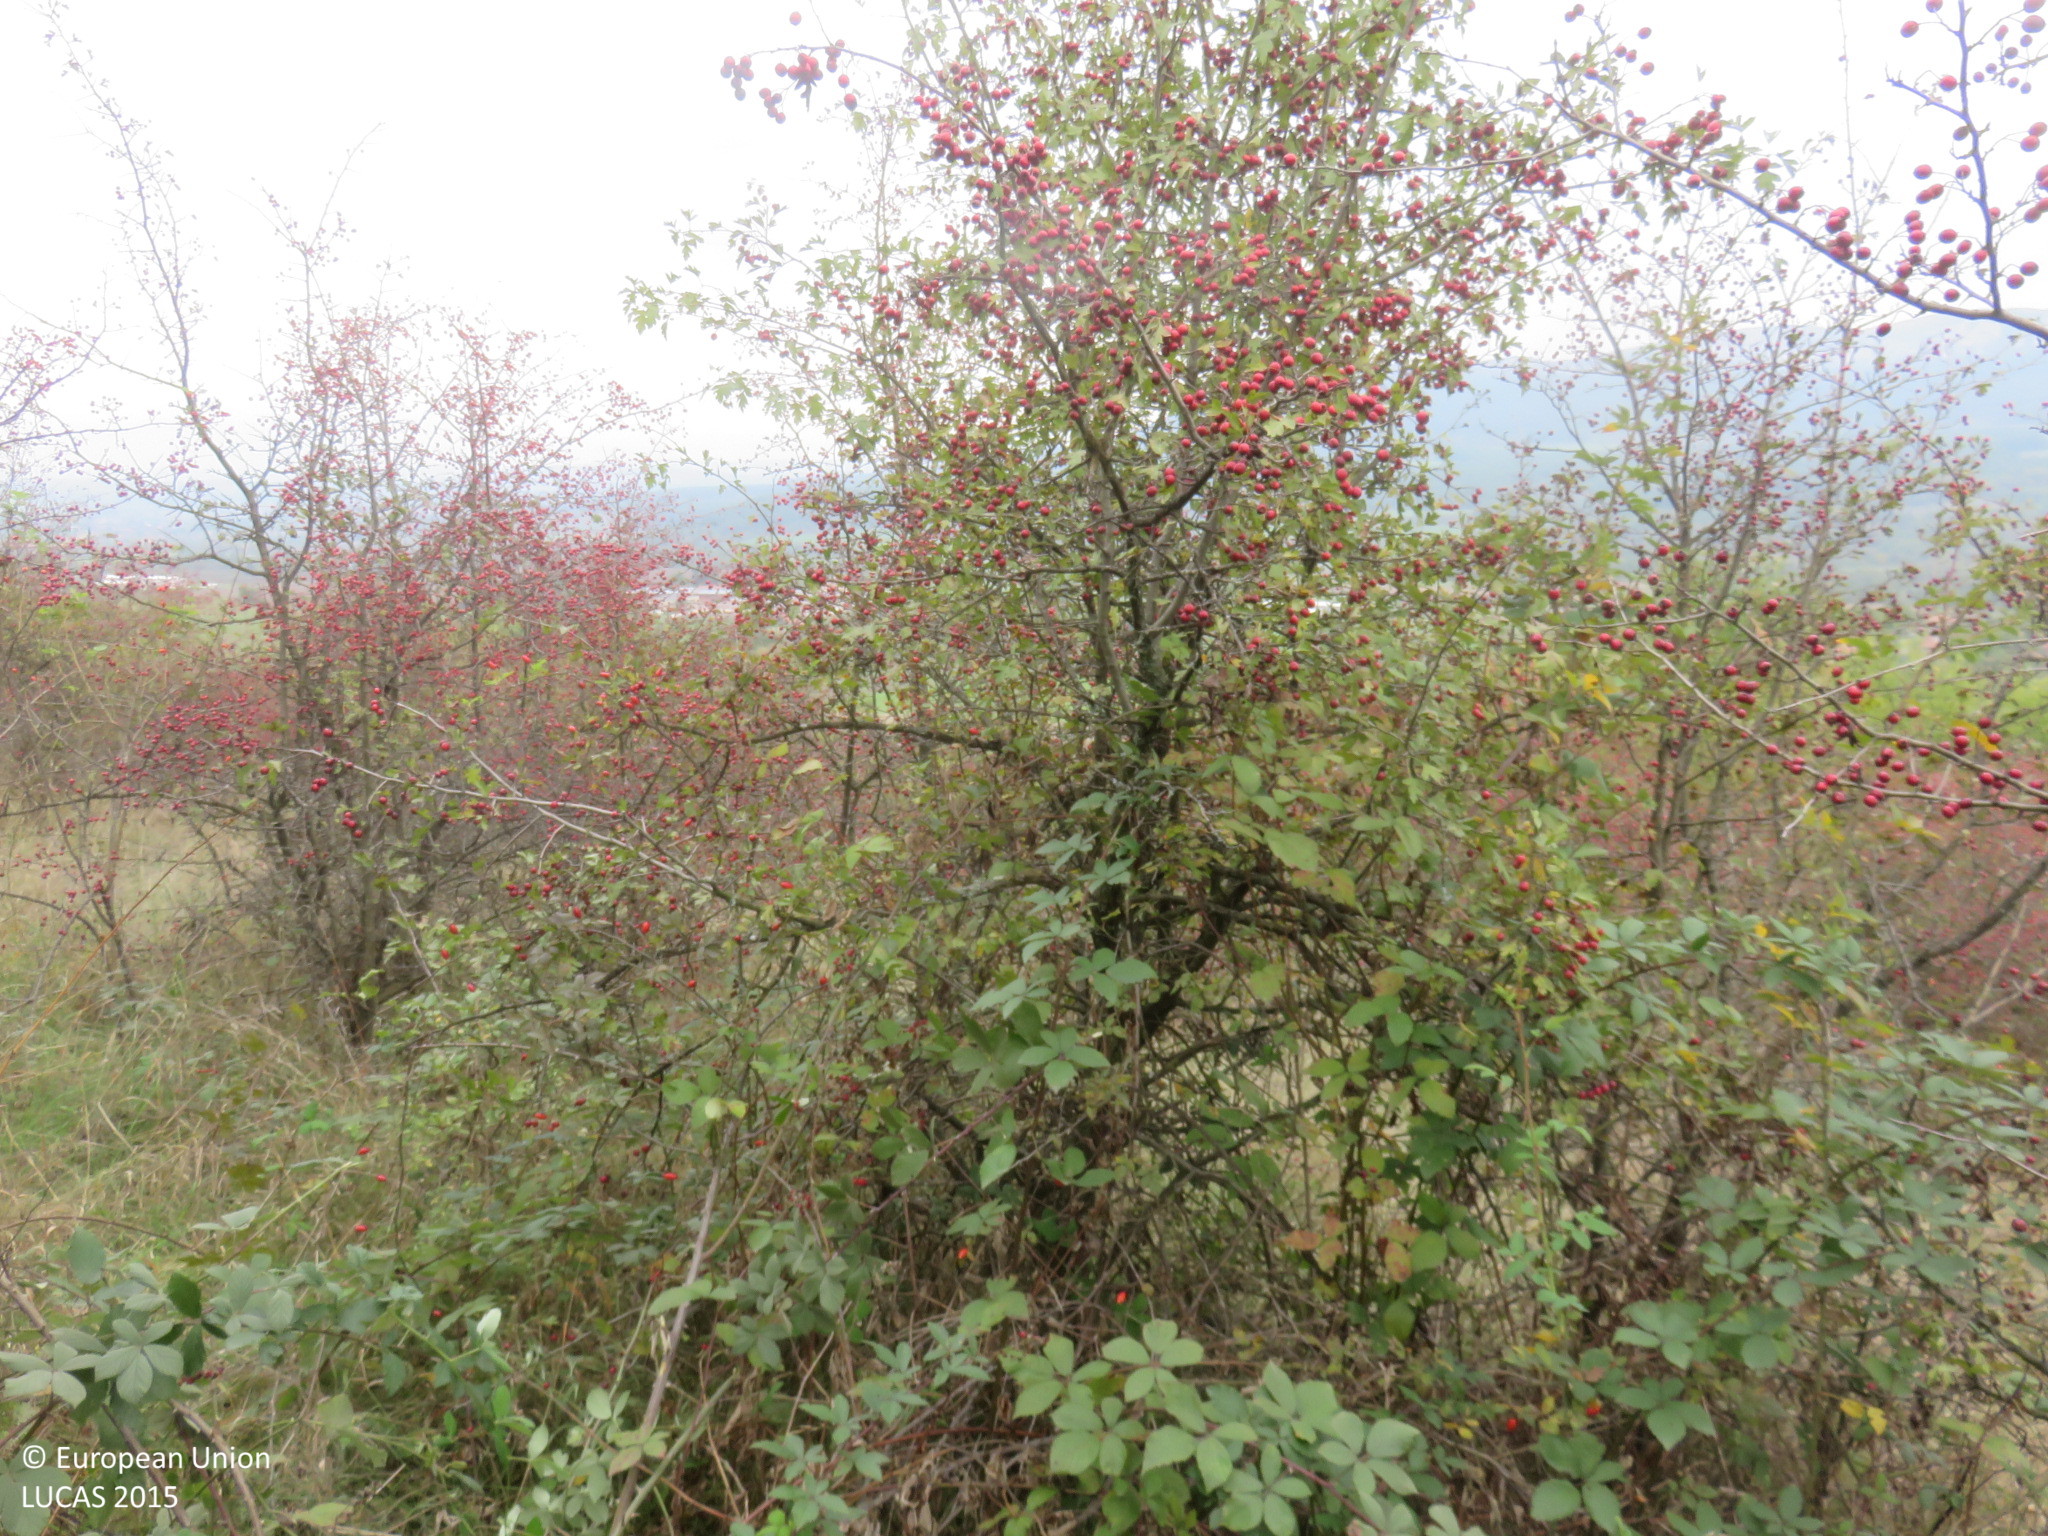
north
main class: Shrubland
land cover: Shrubland with sparse tree cover
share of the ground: > 75 %
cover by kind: shrubs 90 %, broadleaved forest trees 5 %, herbaceous plants 5 %
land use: Semi-natural and natural areas not in use
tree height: < 5 m
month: October
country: BG
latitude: 42.9331
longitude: 25.1771
